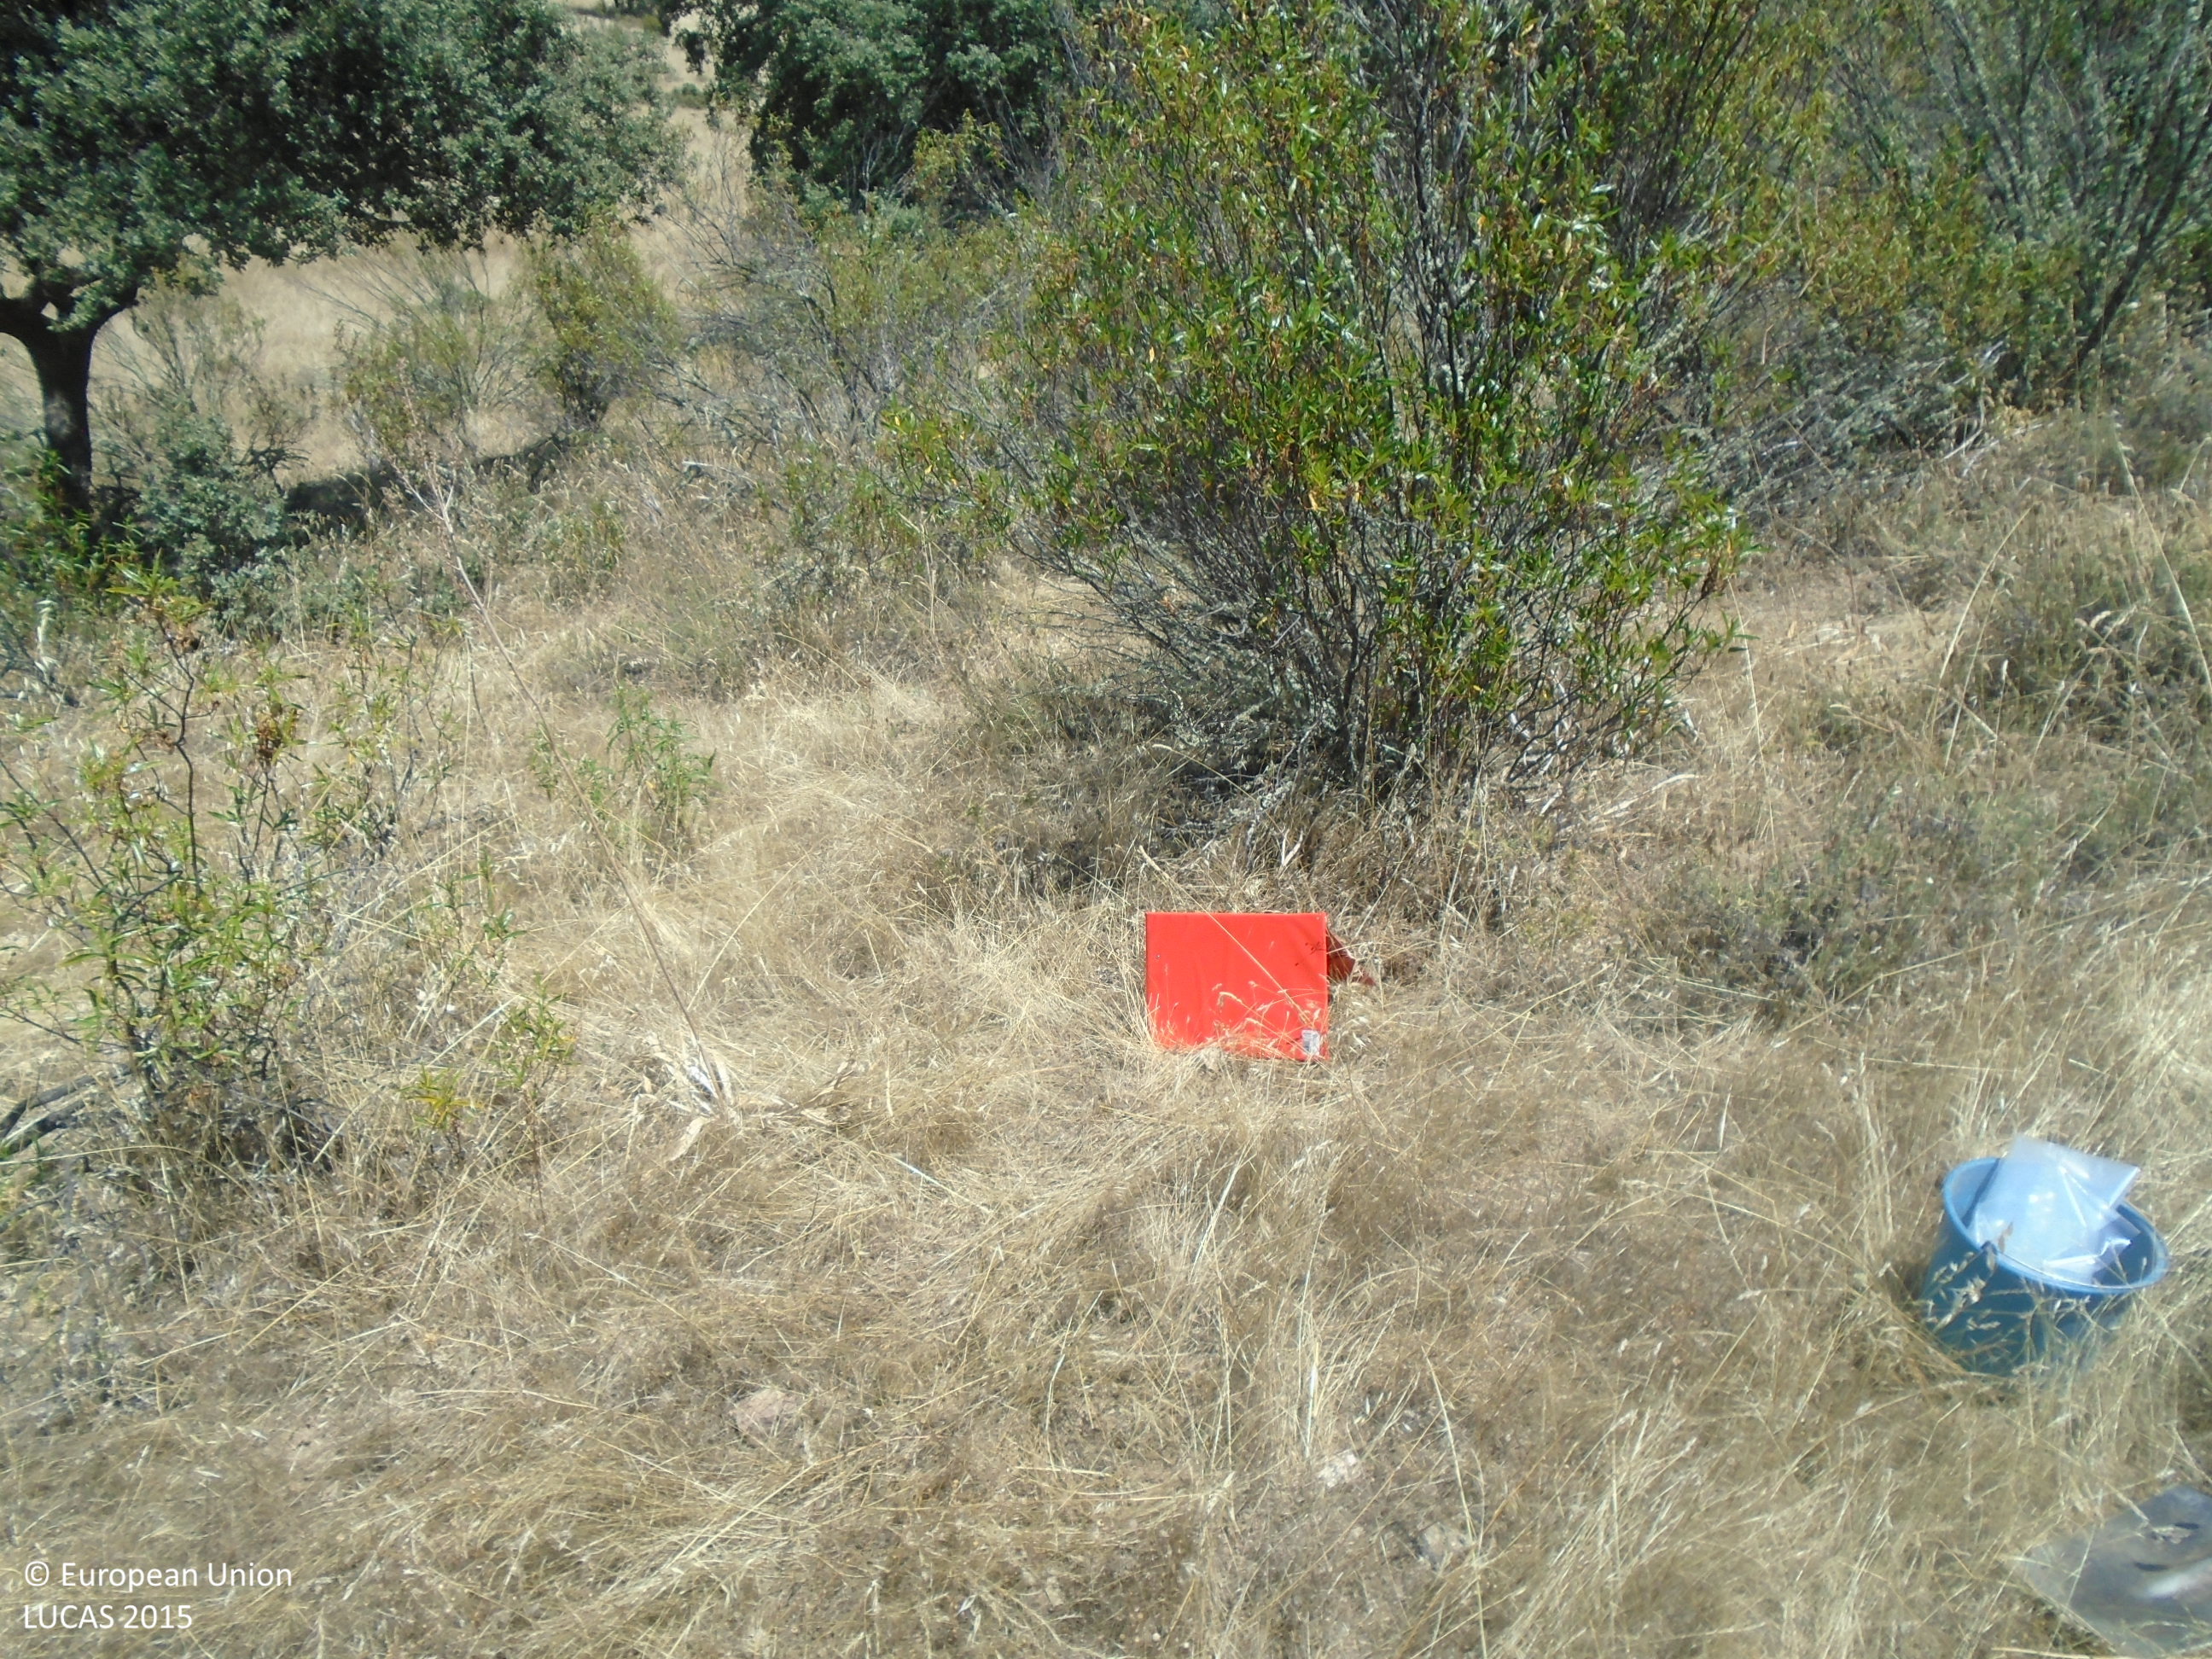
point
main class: Shrubland
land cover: Shrubland with sparse tree cover
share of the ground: > 75 %
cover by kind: shrubs 85 %, broadleaved forest trees 5 %, herbaceous plants 5 %, consolidated bare surface 5 %
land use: Semi-natural and natural areas not in use
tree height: > 5 m
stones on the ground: 10 - 25 %
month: July
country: ES
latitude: 39.4486
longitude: -4.8093
